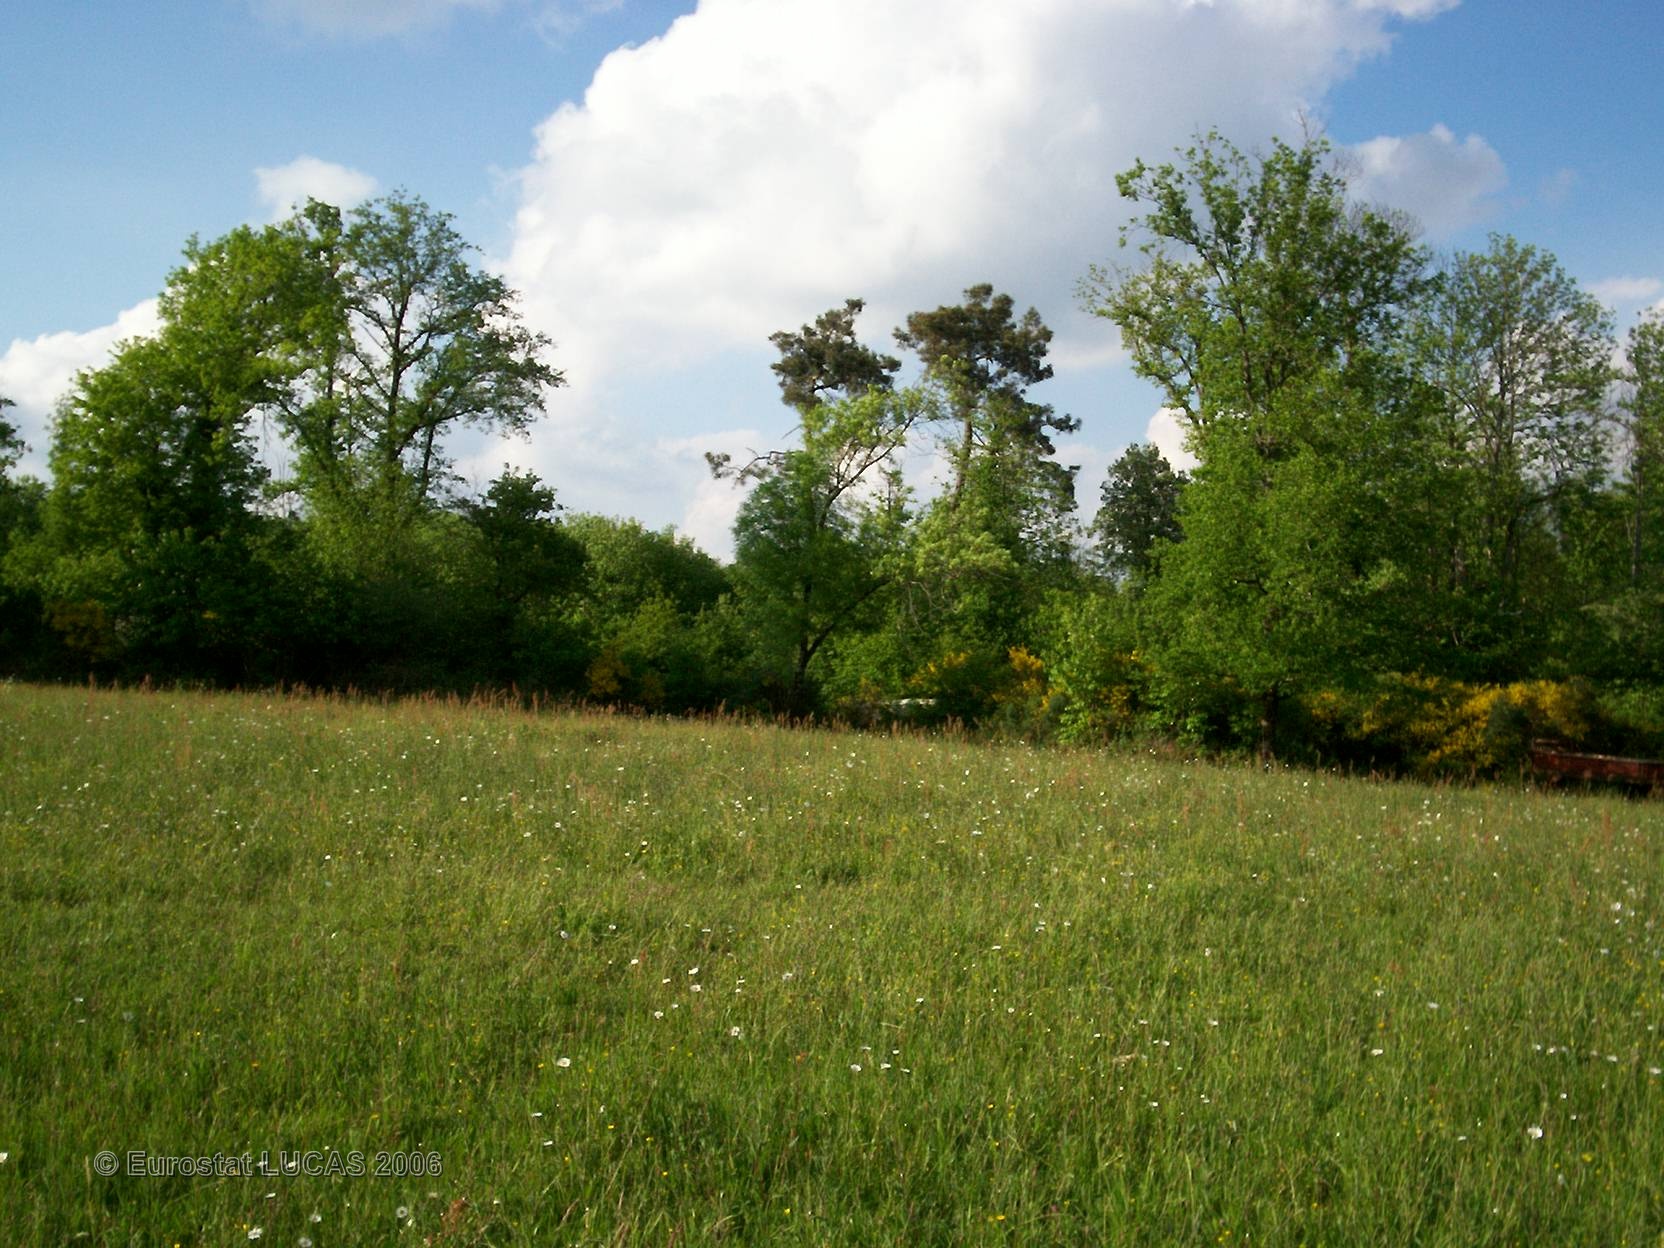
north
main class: Grassland
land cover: Grassland without tree/shrub cover
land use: Agriculture (excluding fallow land and kitchen gardens)
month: May
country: FR
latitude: 45.7093
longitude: 0.4933
